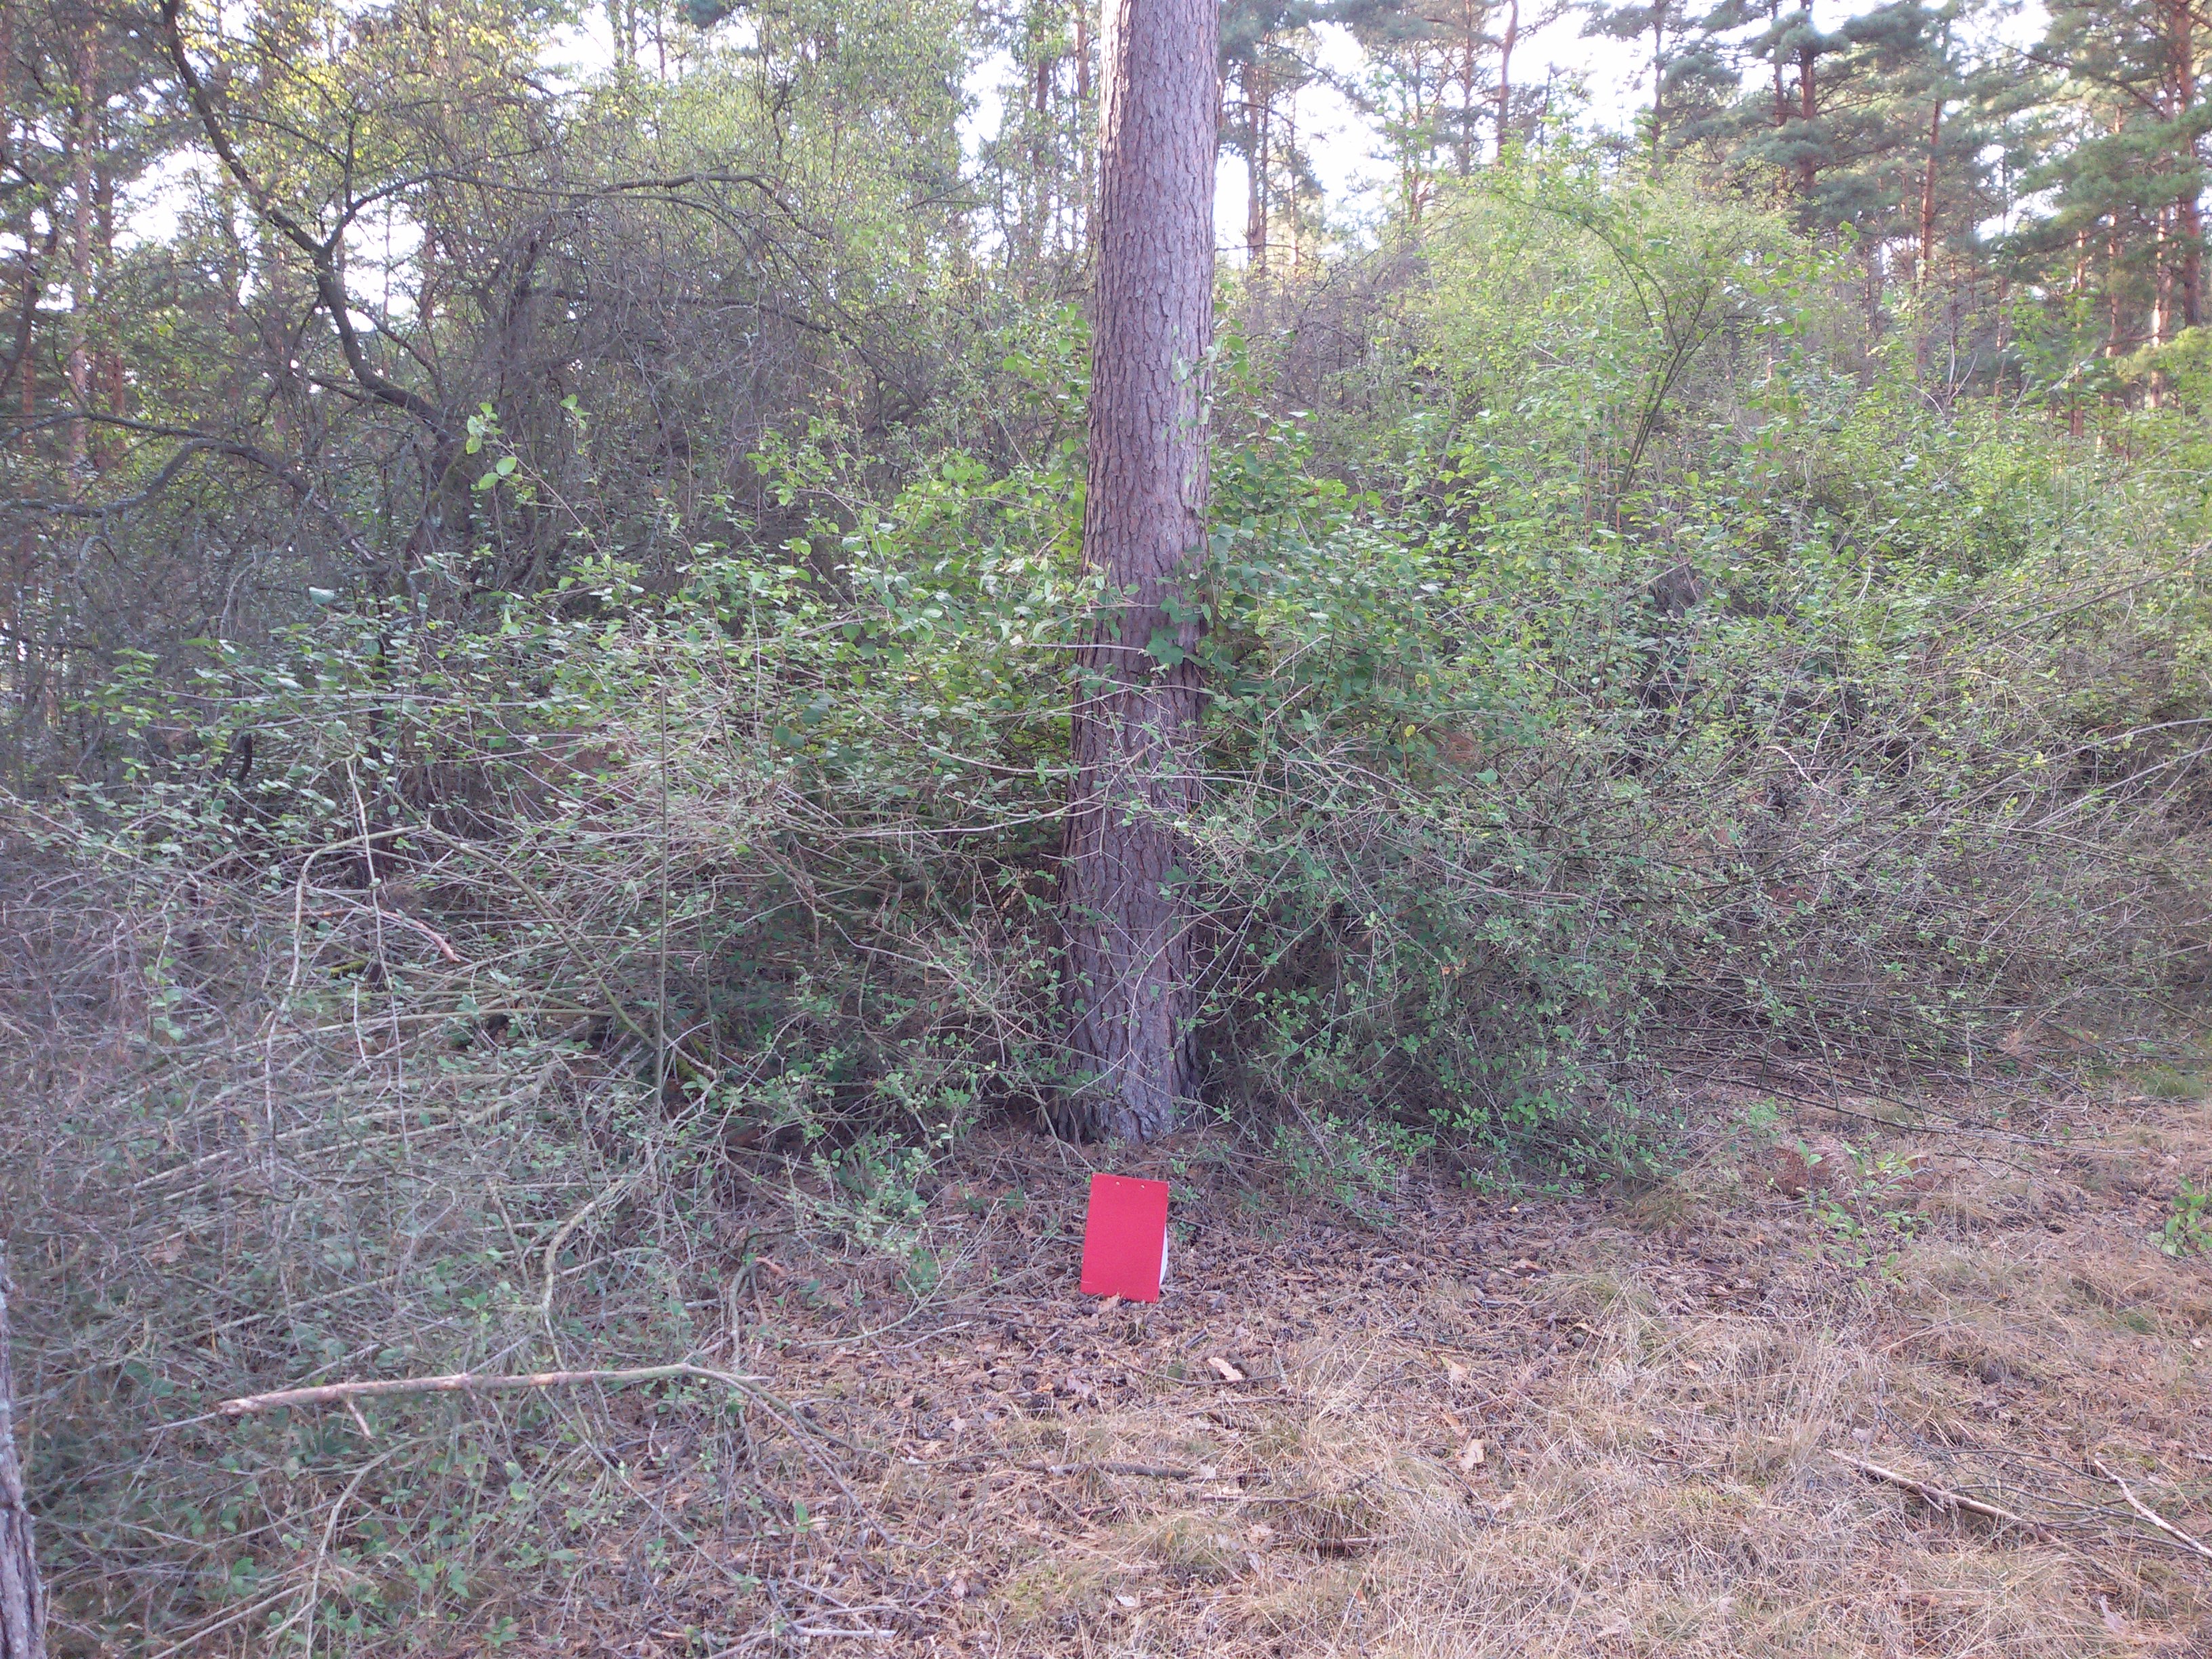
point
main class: Woodland
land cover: Pine dominated coniferous woodland
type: hemiboreal forest and nemoral coniferous forest and mixed broadleaved-coniferous forest
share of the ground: 50 - 75 %
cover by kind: coniferous forest trees 45 %, shrubs 25 %, herbaceous plants 15 %, broadleaved forest trees 10 %, lichens and mosses 5 %
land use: Forestry
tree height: > 5 m
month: September
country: PL
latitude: 53.0721
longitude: 17.6098
